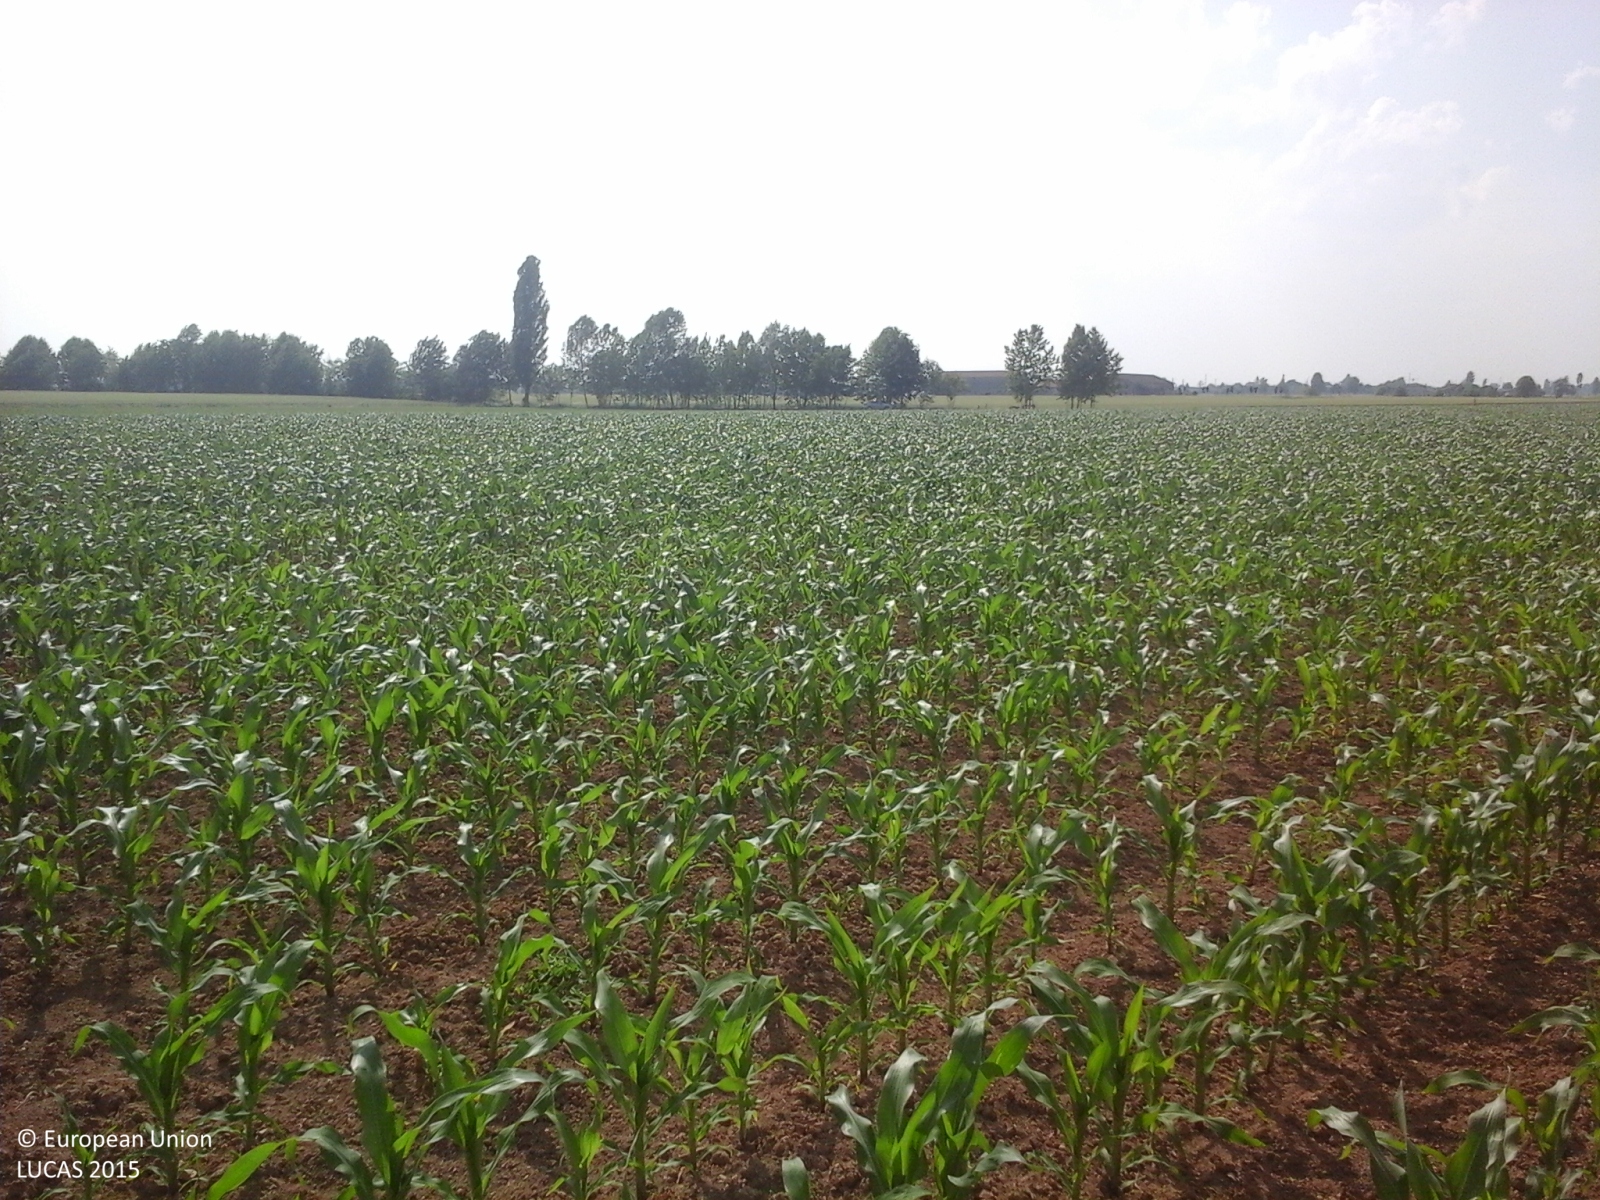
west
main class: Cropland
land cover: Maize
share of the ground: 25 - 50 %
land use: Agriculture (excluding fallow land and kitchen gardens)
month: May
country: IT
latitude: 45.2322
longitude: 10.6230
